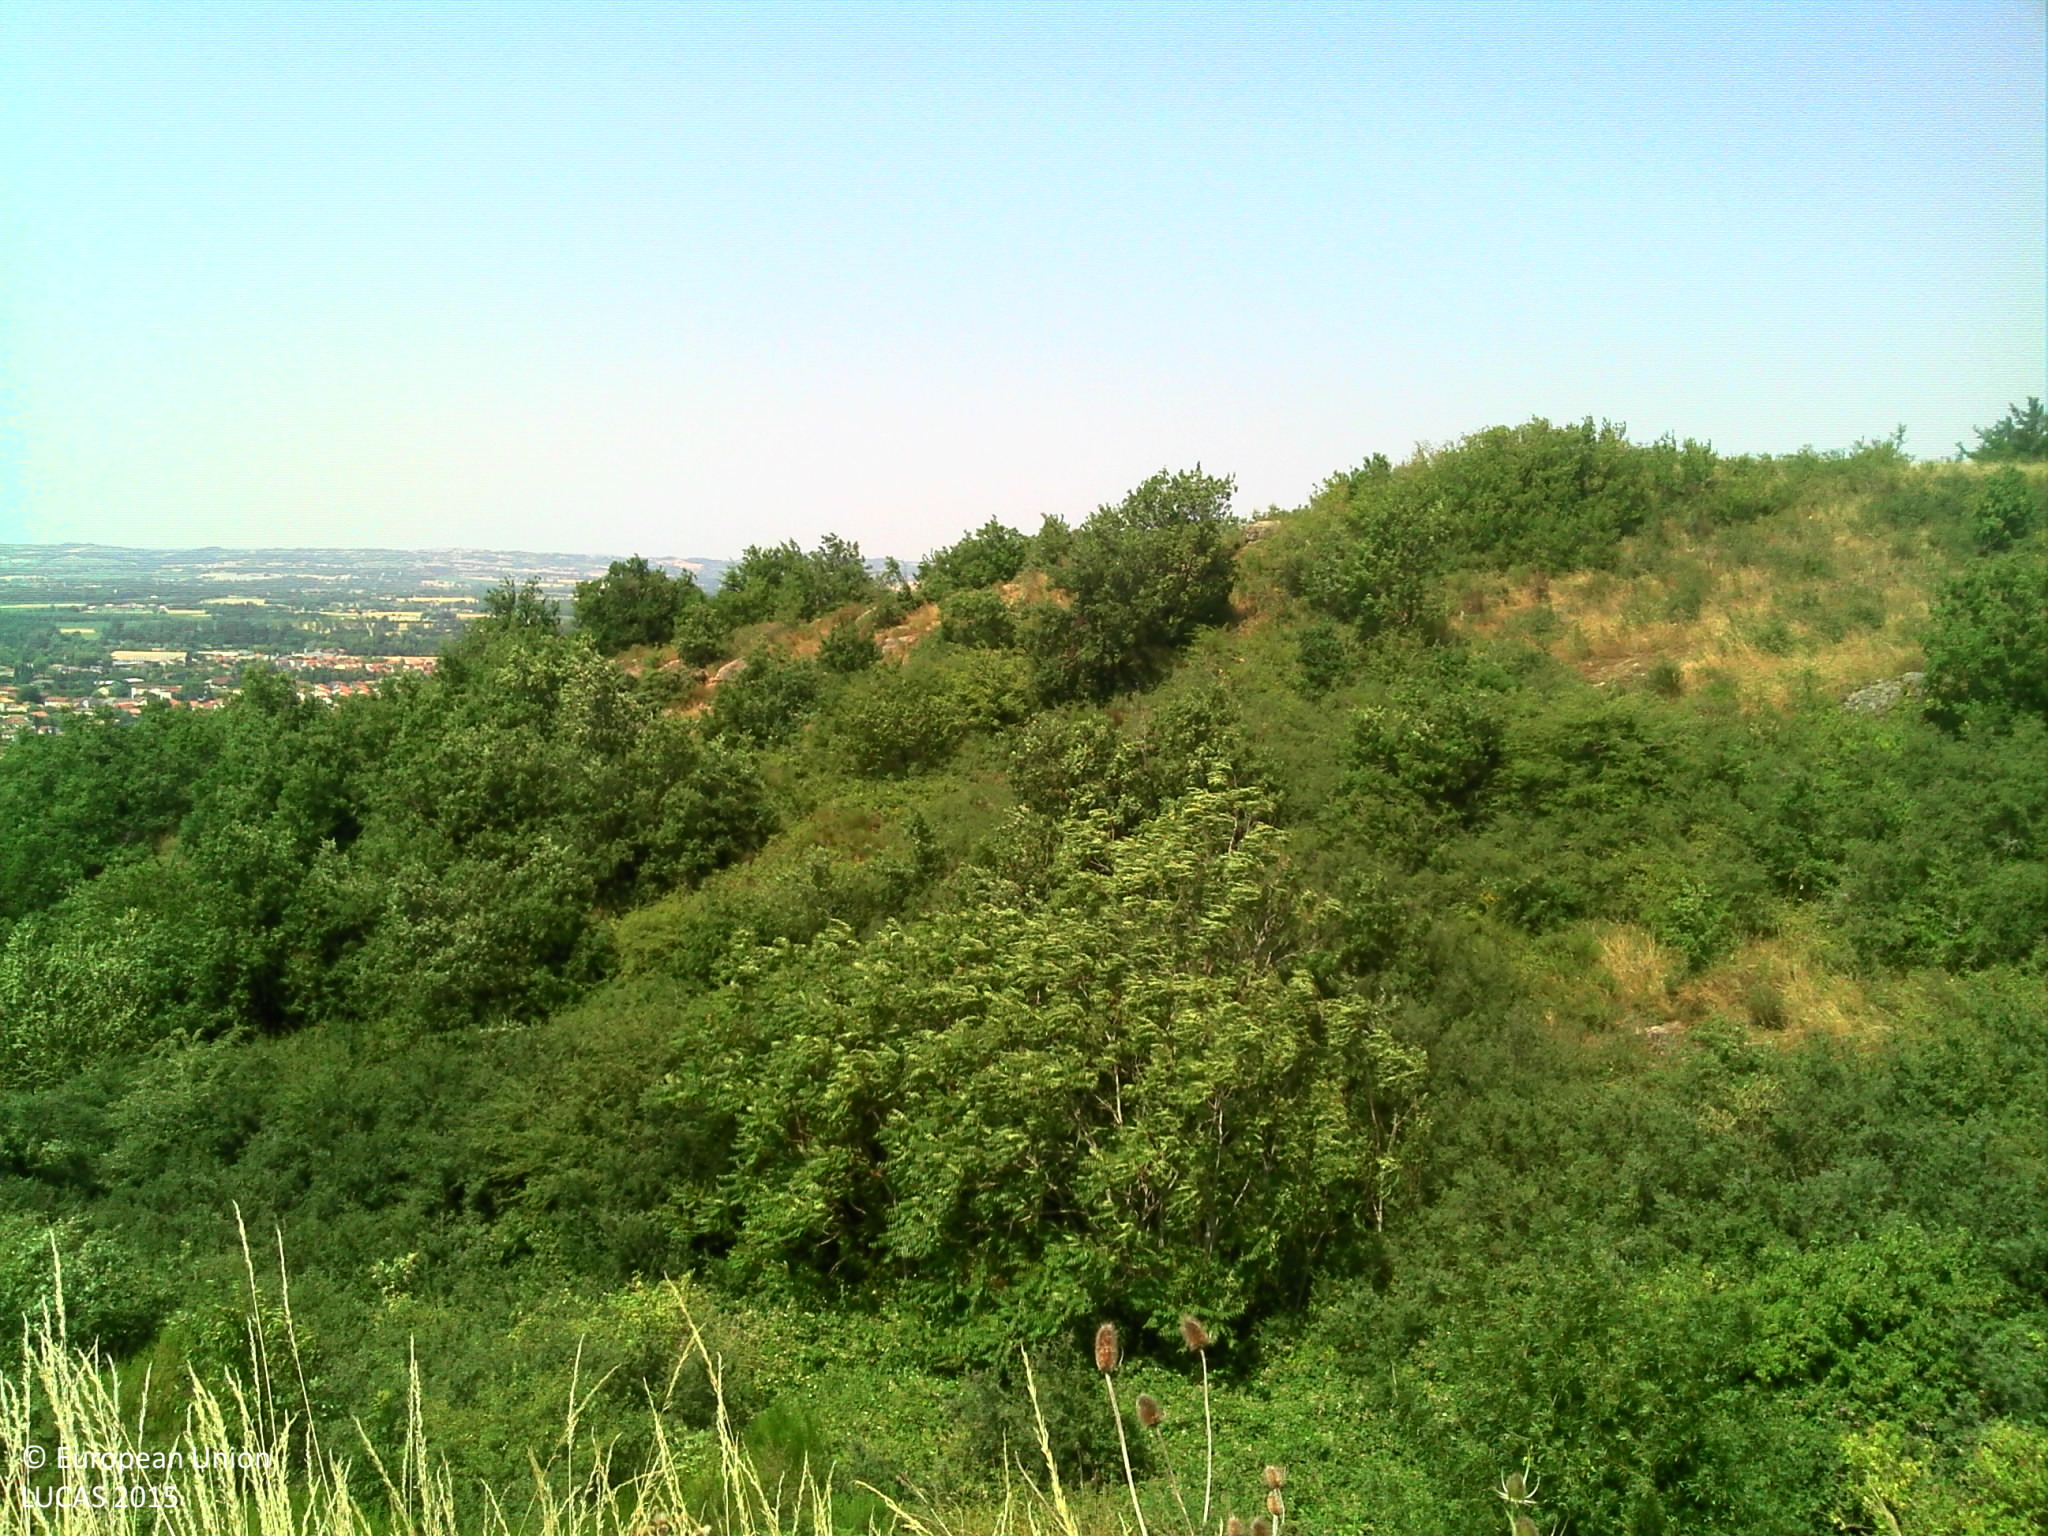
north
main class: Shrubland
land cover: Shrubland with sparse tree cover
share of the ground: > 75 %
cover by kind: shrubs 65 %, herbaceous plants 30 %, broadleaved forest trees 5 %
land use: Semi-natural and natural areas not in use
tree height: < 5 m
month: July
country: FR
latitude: 43.4442
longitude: 2.0114
